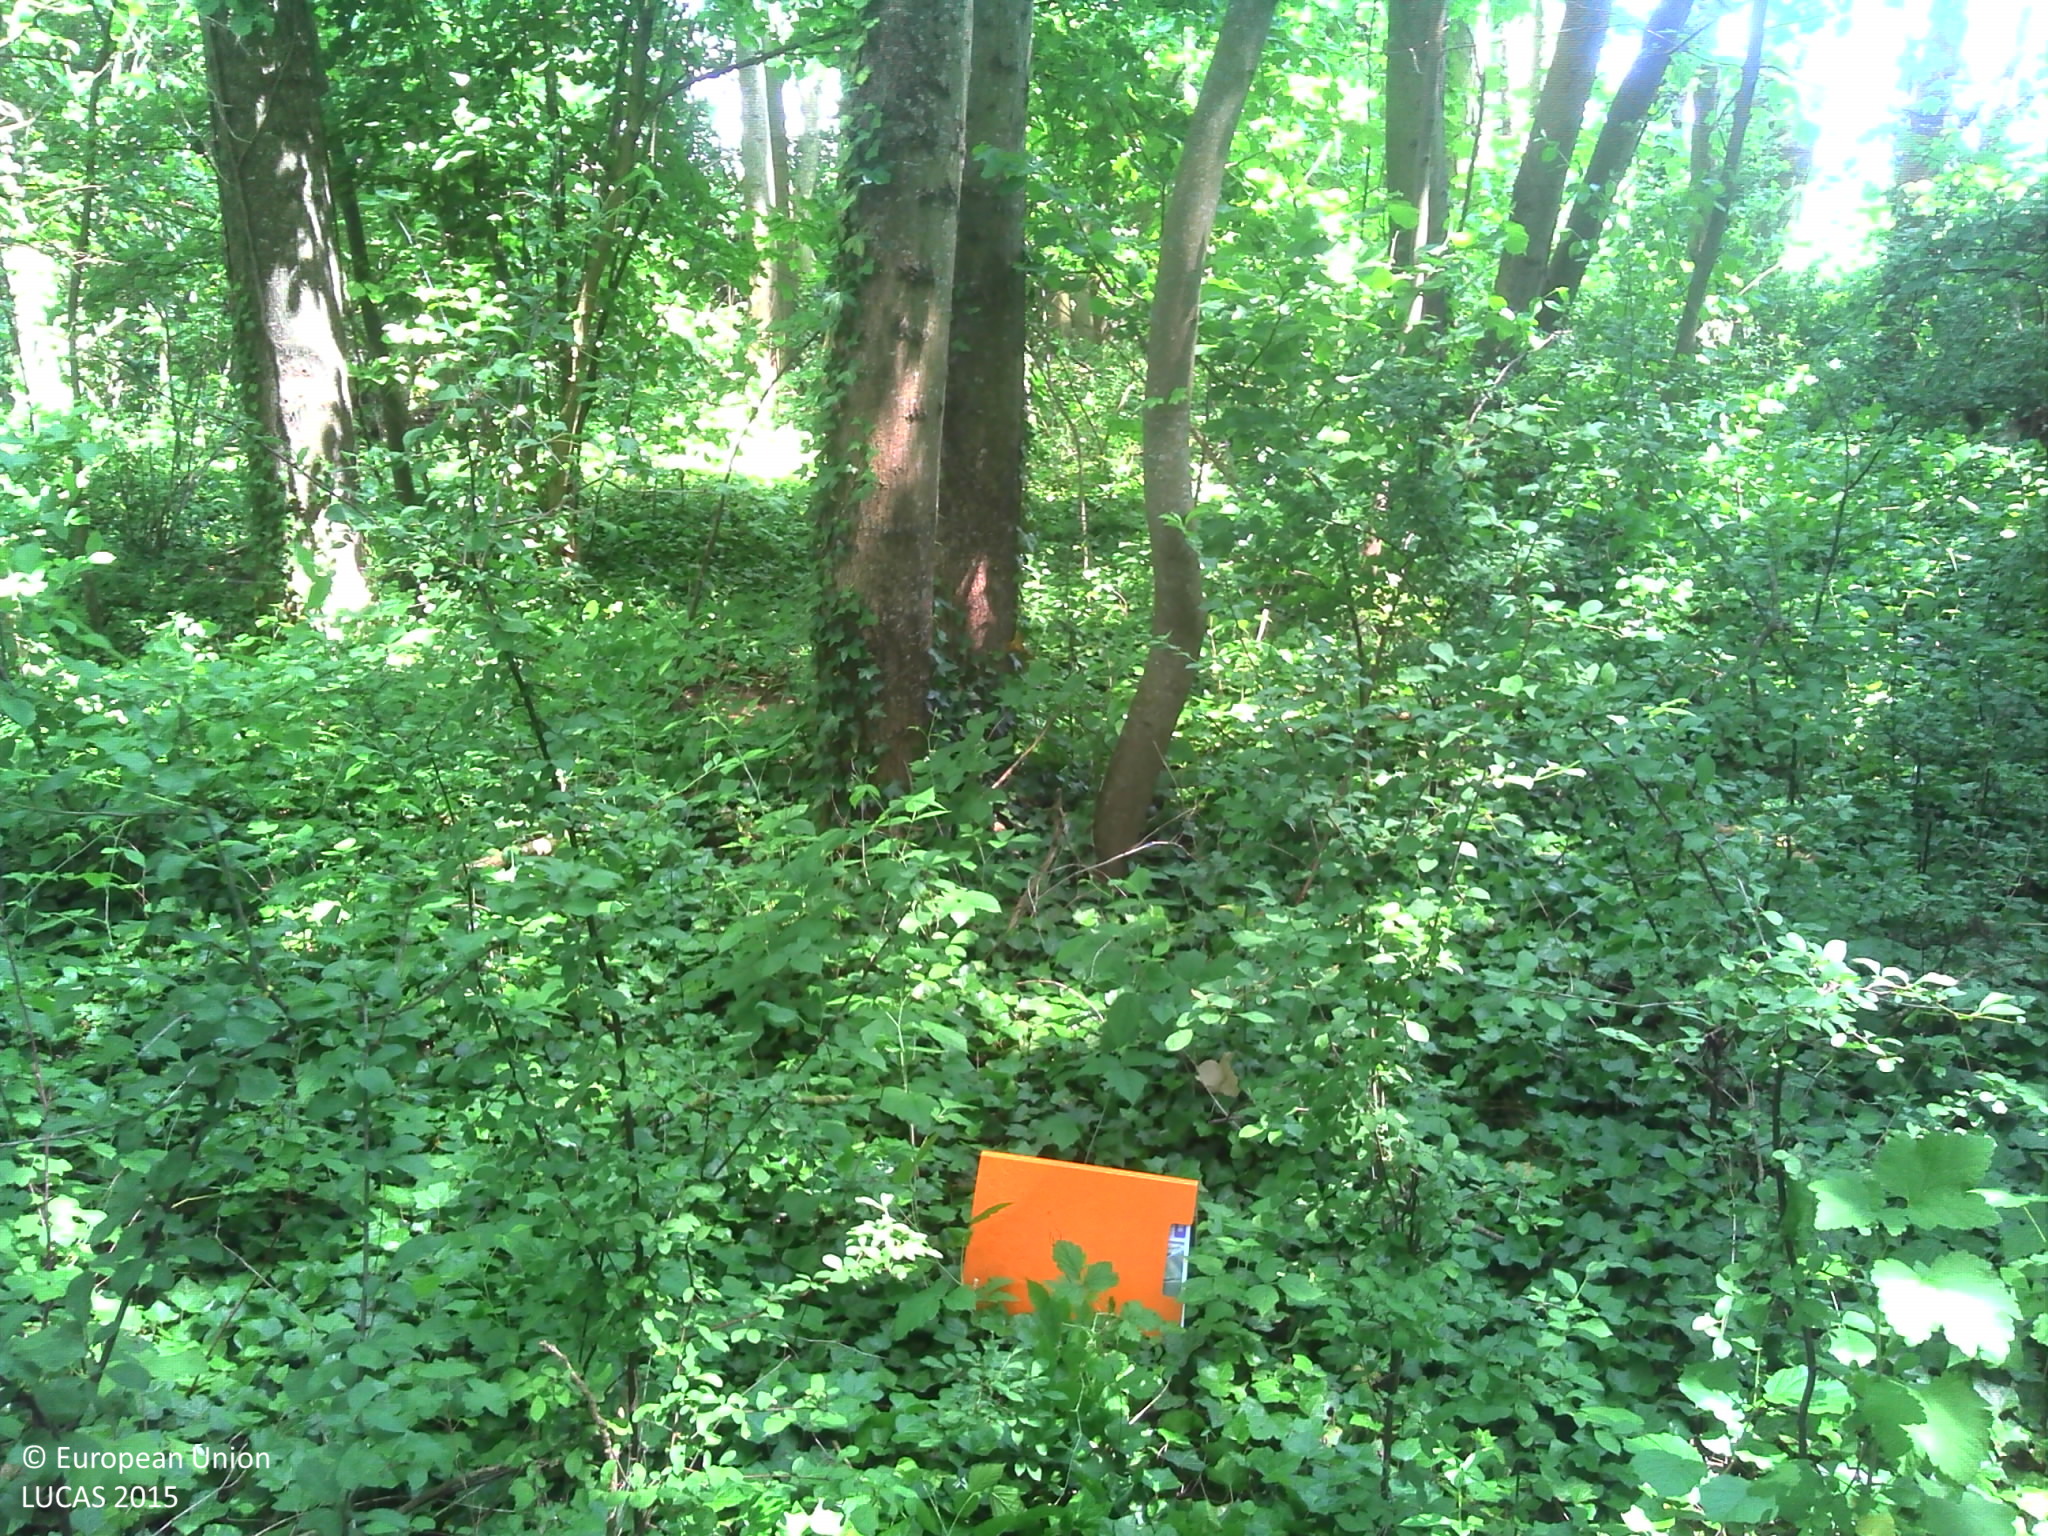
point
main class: Woodland
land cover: Broadleaved woodland
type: mesophytic deciduous forest
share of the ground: > 75 %
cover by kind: broadleaved forest trees 90 %, shrubs 5 %, herbaceous plants 5 %
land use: Semi-natural and natural areas not in use
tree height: > 5 m
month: June
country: FR
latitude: 49.5608
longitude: 4.0639
